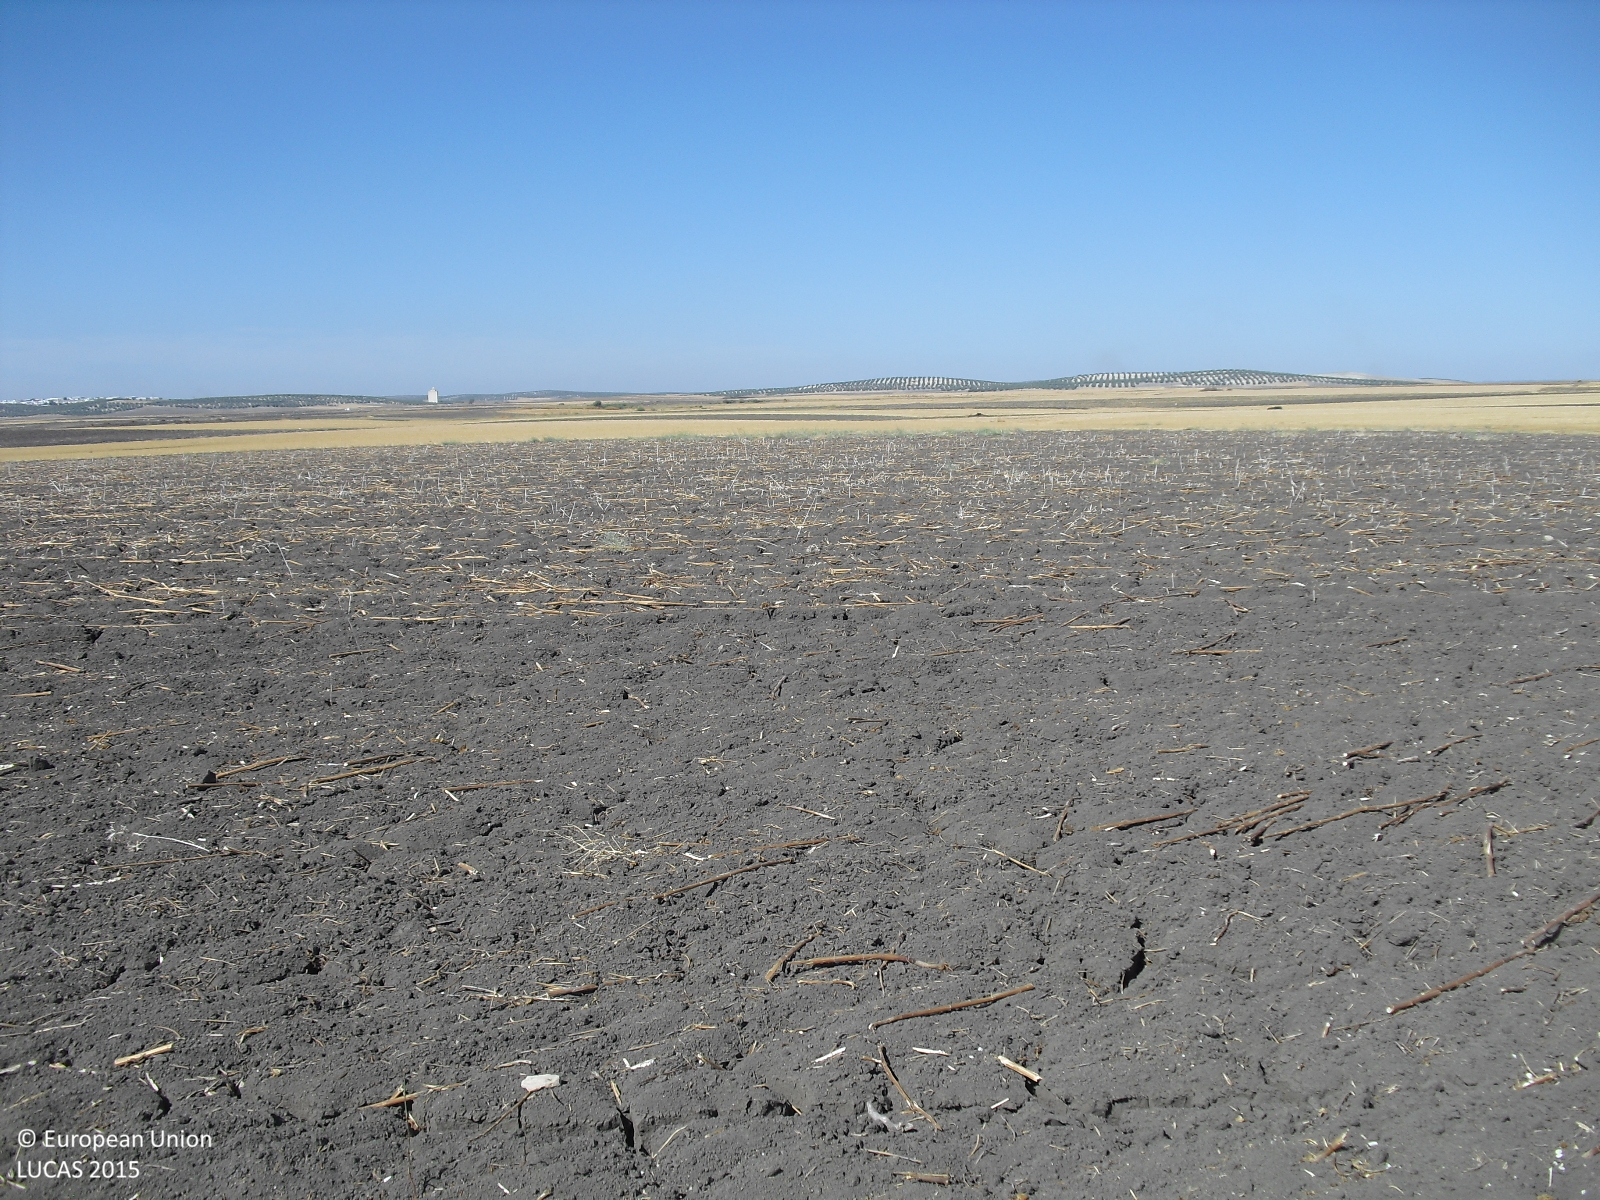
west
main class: Cropland
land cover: Sunflower
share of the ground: < 10 %
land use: Agriculture (excluding fallow land and kitchen gardens)
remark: Harvested field
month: August
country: ES
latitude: 37.3218
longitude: -5.4630
